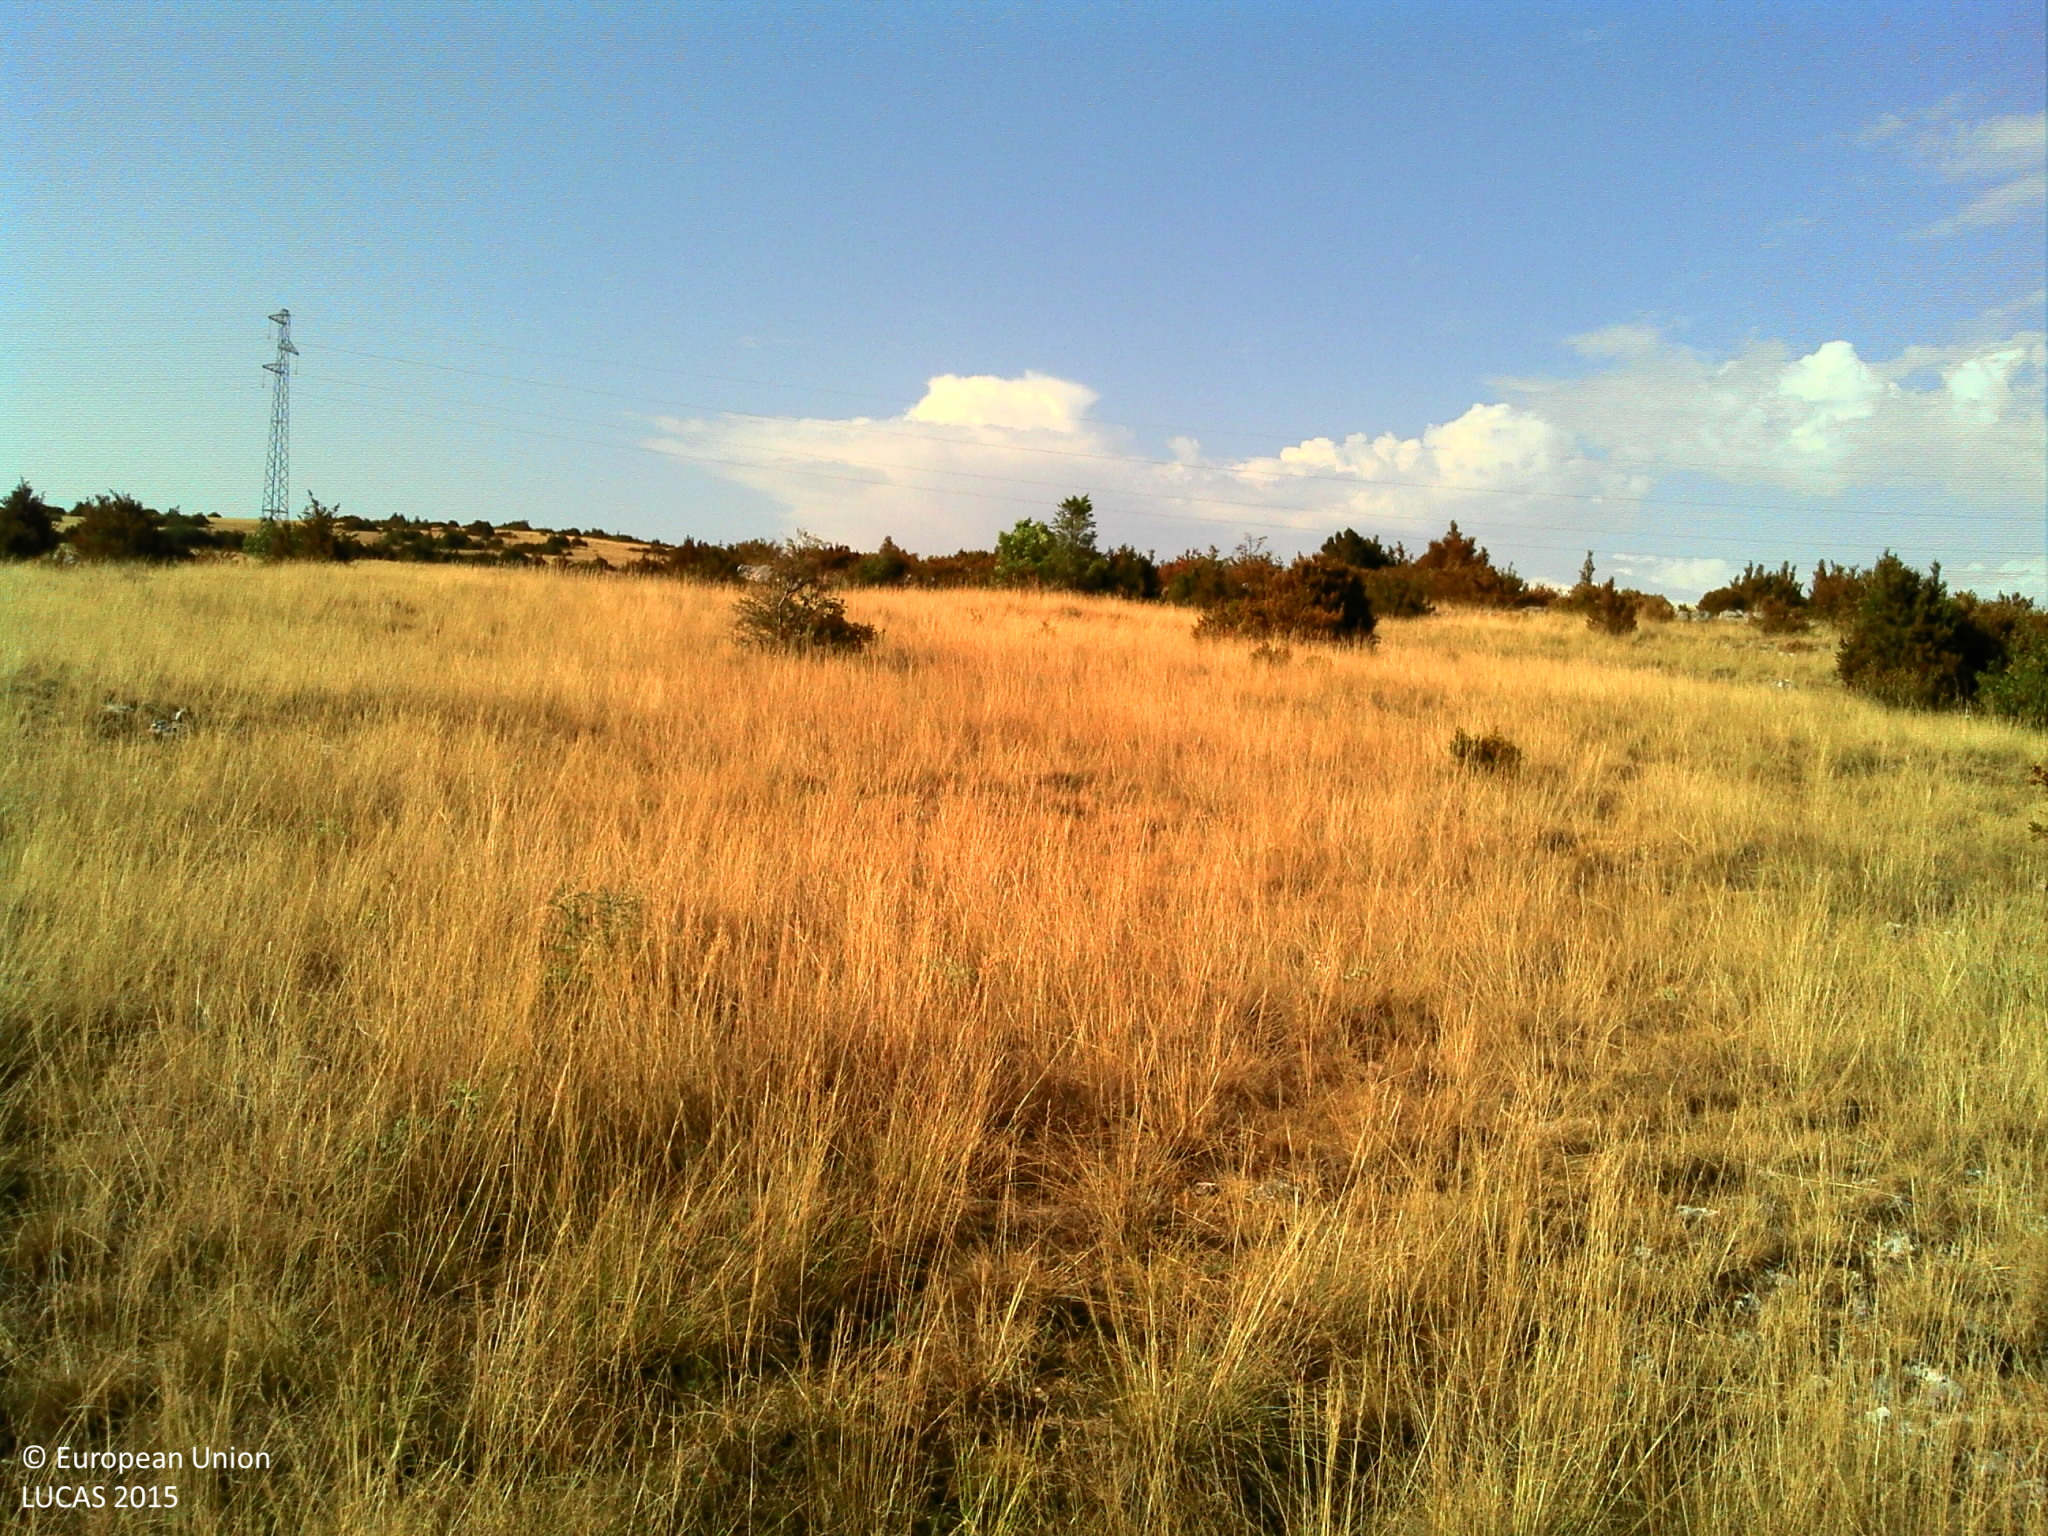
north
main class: Grassland
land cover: Grassland without tree/shrub cover
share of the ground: > 75 %
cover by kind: herbaceous plants 95 %, shrubs 5 %
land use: Agriculture (excluding fallow land and kitchen gardens)
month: August
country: FR
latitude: 43.9589
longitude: 3.1149
